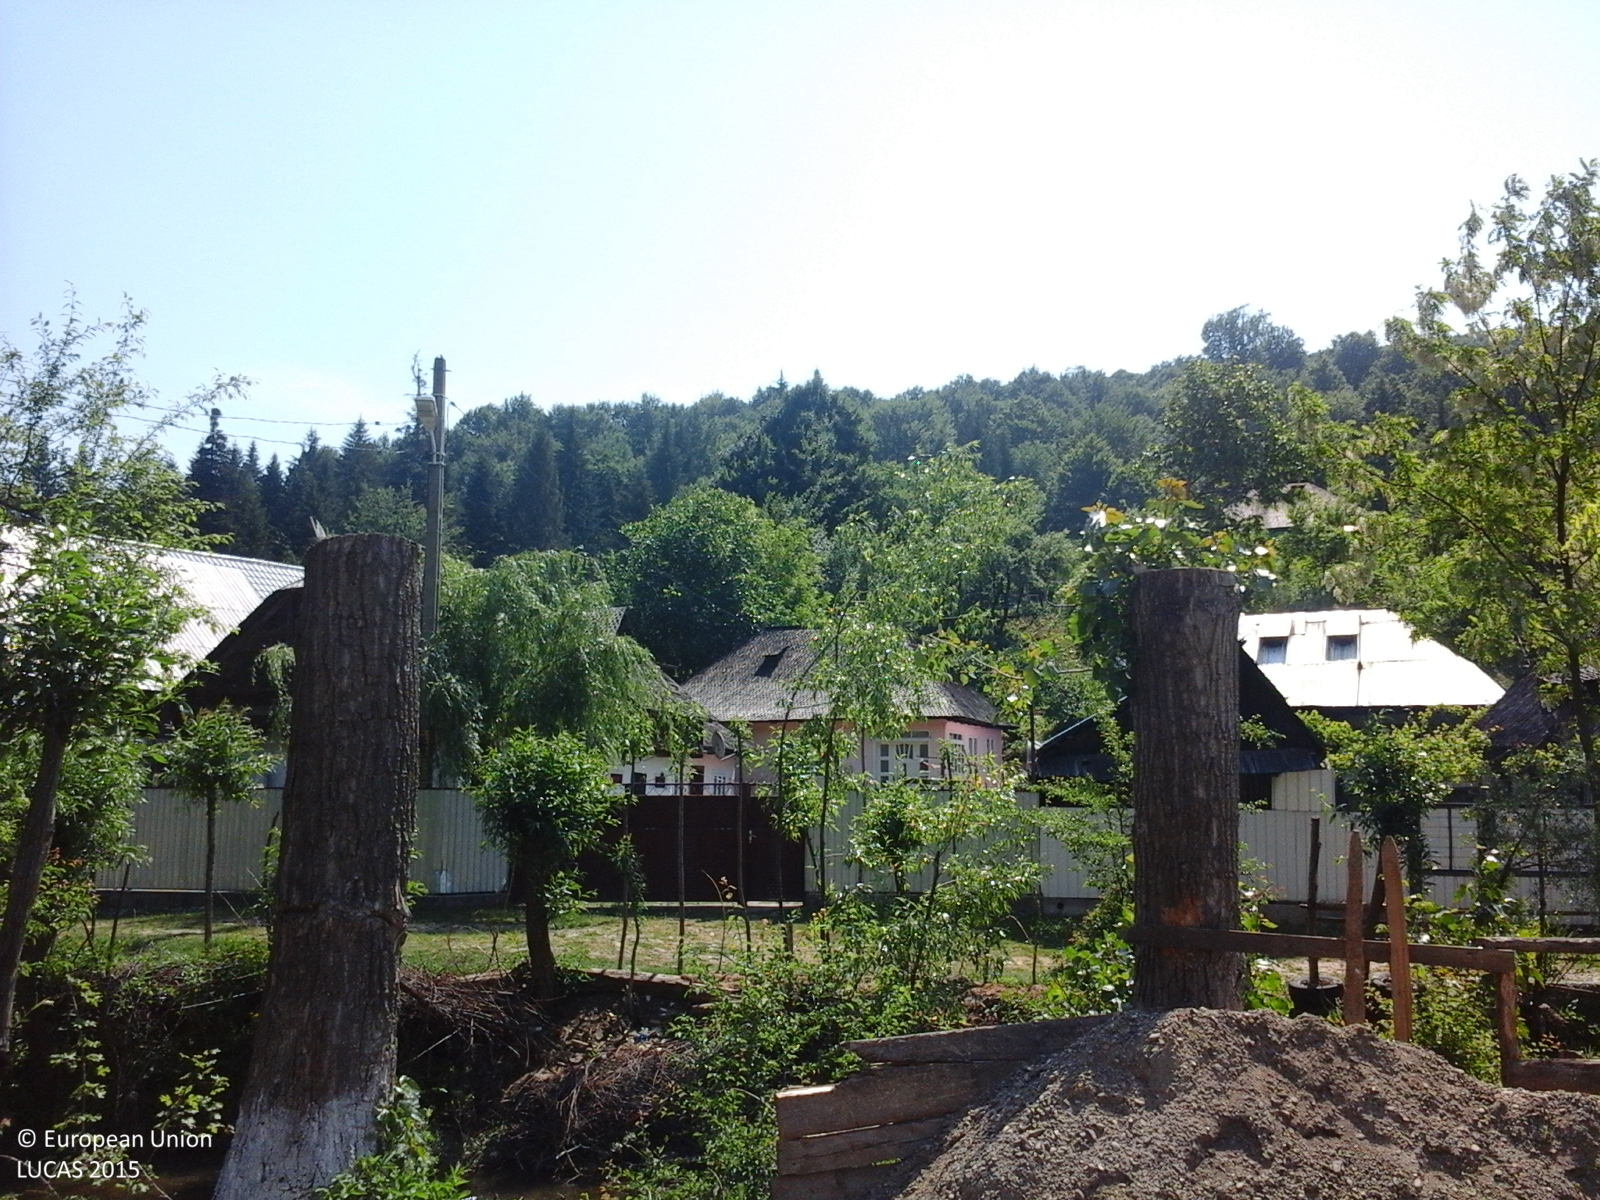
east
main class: Woodland
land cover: Other mixed woodland
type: beech forest
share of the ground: > 75 %
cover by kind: broadleaved forest trees 70 %, coniferous forest trees 30 %
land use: Forestry
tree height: > 5 m
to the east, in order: Other mixed woodland; Electric lines; Other mixed woodland; Artificial constructions in urban areas; Rivers and streams; Artificial constructions in urban areas; Rivers and streams; Broadleaved woodland
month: June
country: RO
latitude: 46.6376
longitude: 26.5035
